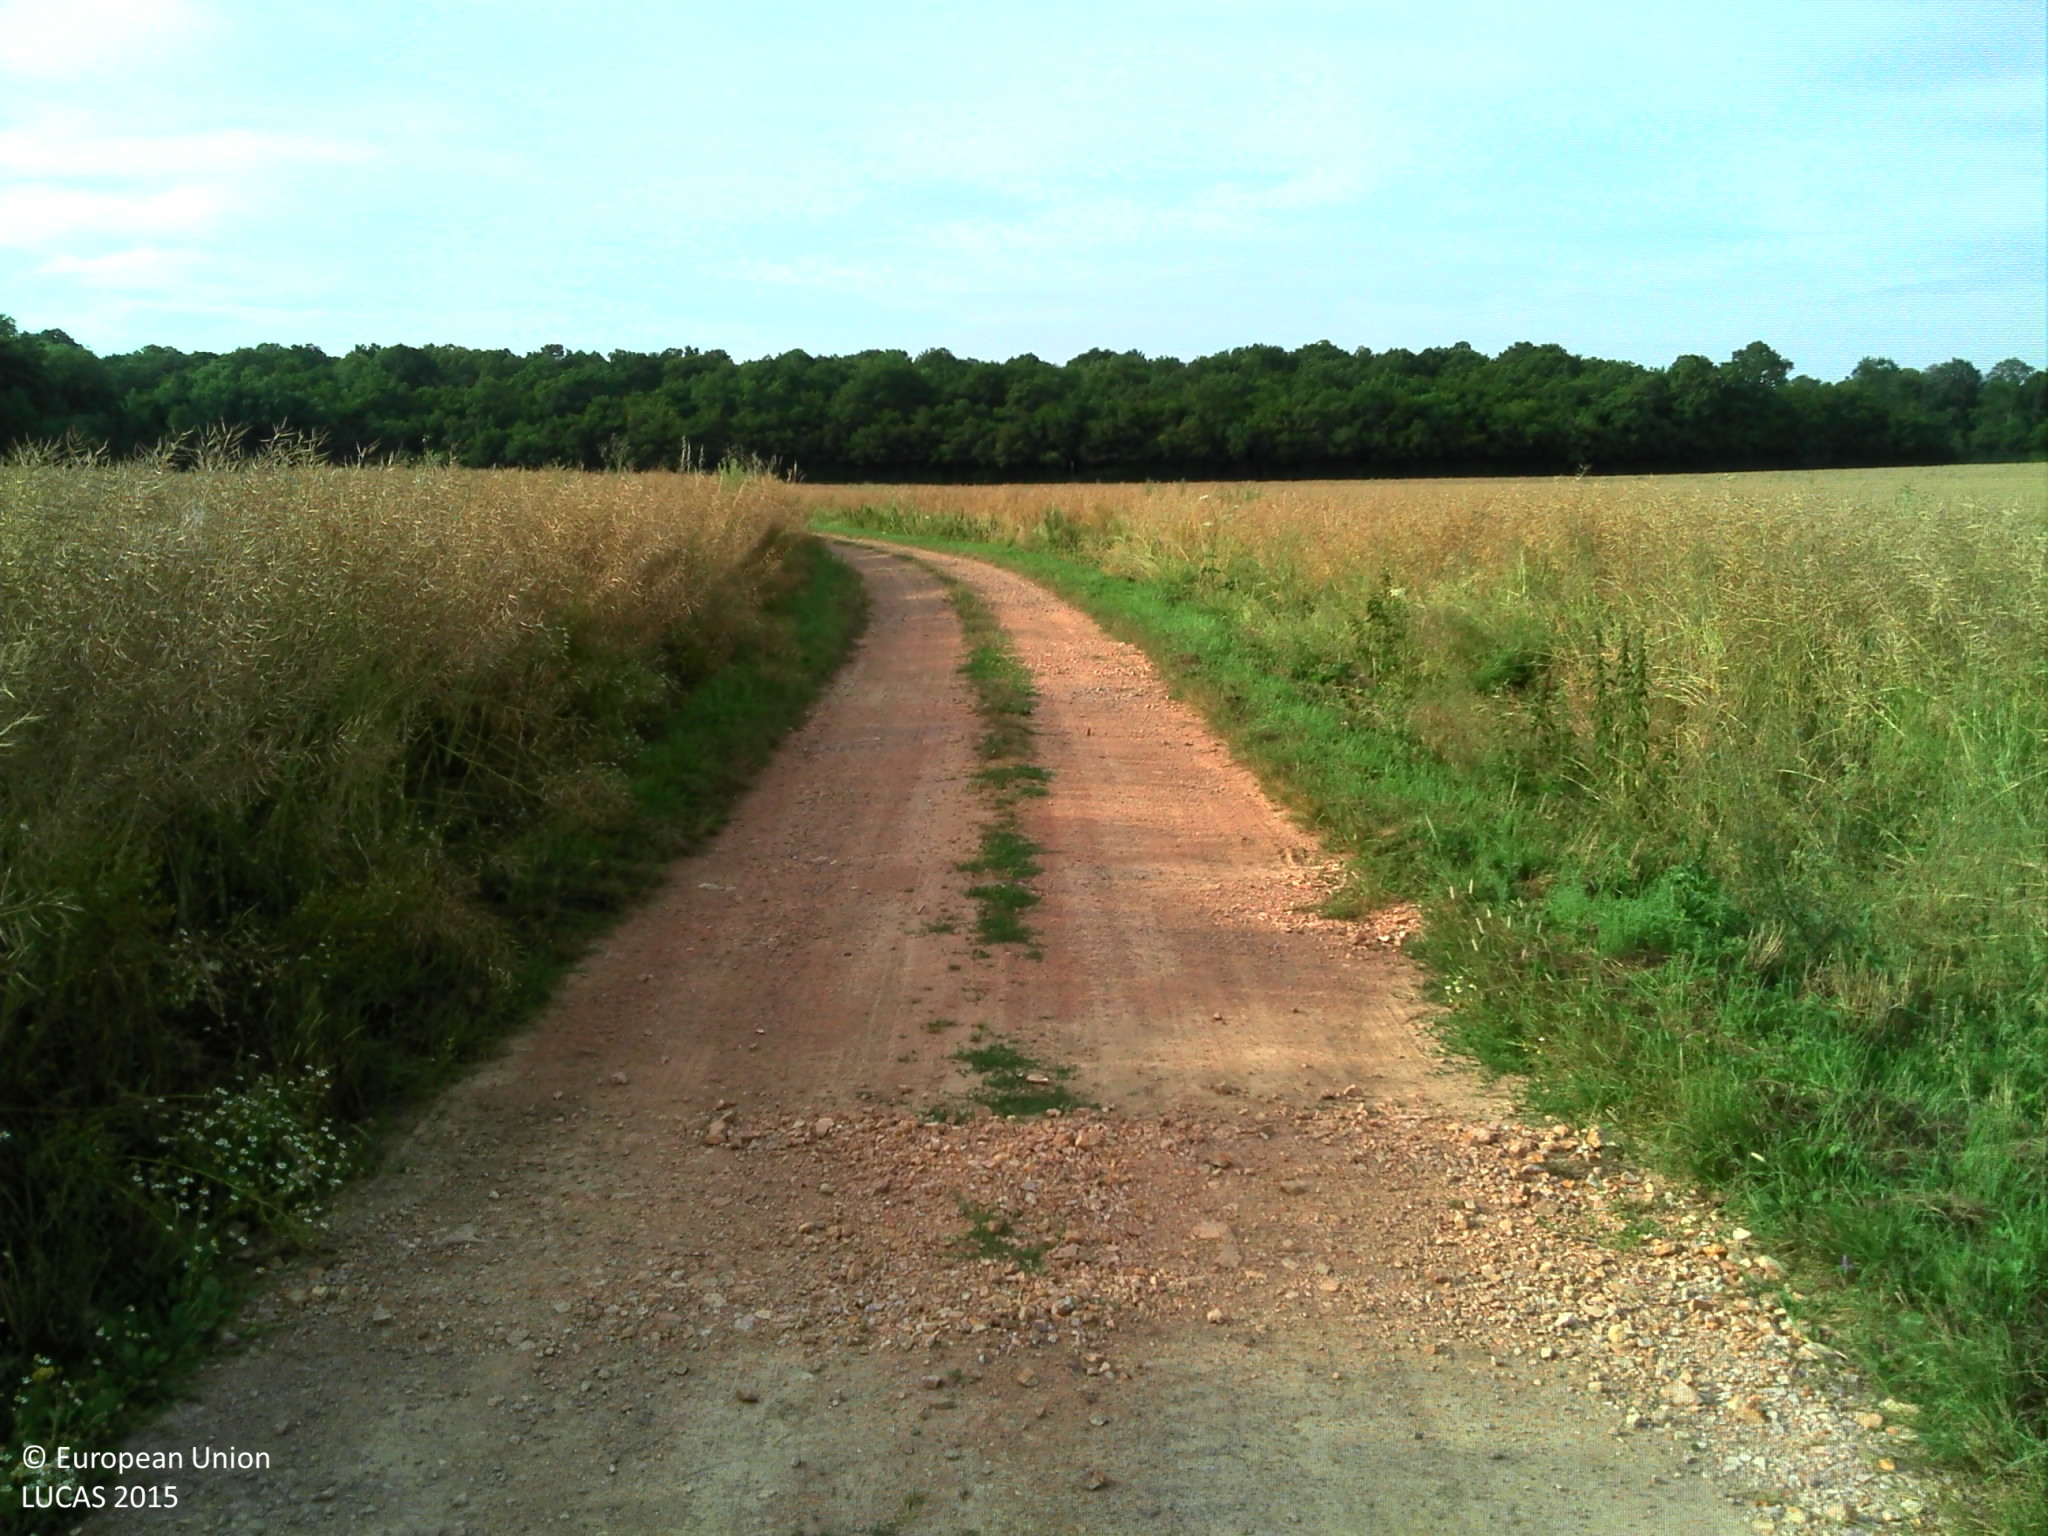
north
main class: Cropland
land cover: Rape and turnip rape
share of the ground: > 75 %
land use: Agriculture (excluding fallow land and kitchen gardens)
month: July
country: FR
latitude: 47.1514
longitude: 3.5746
